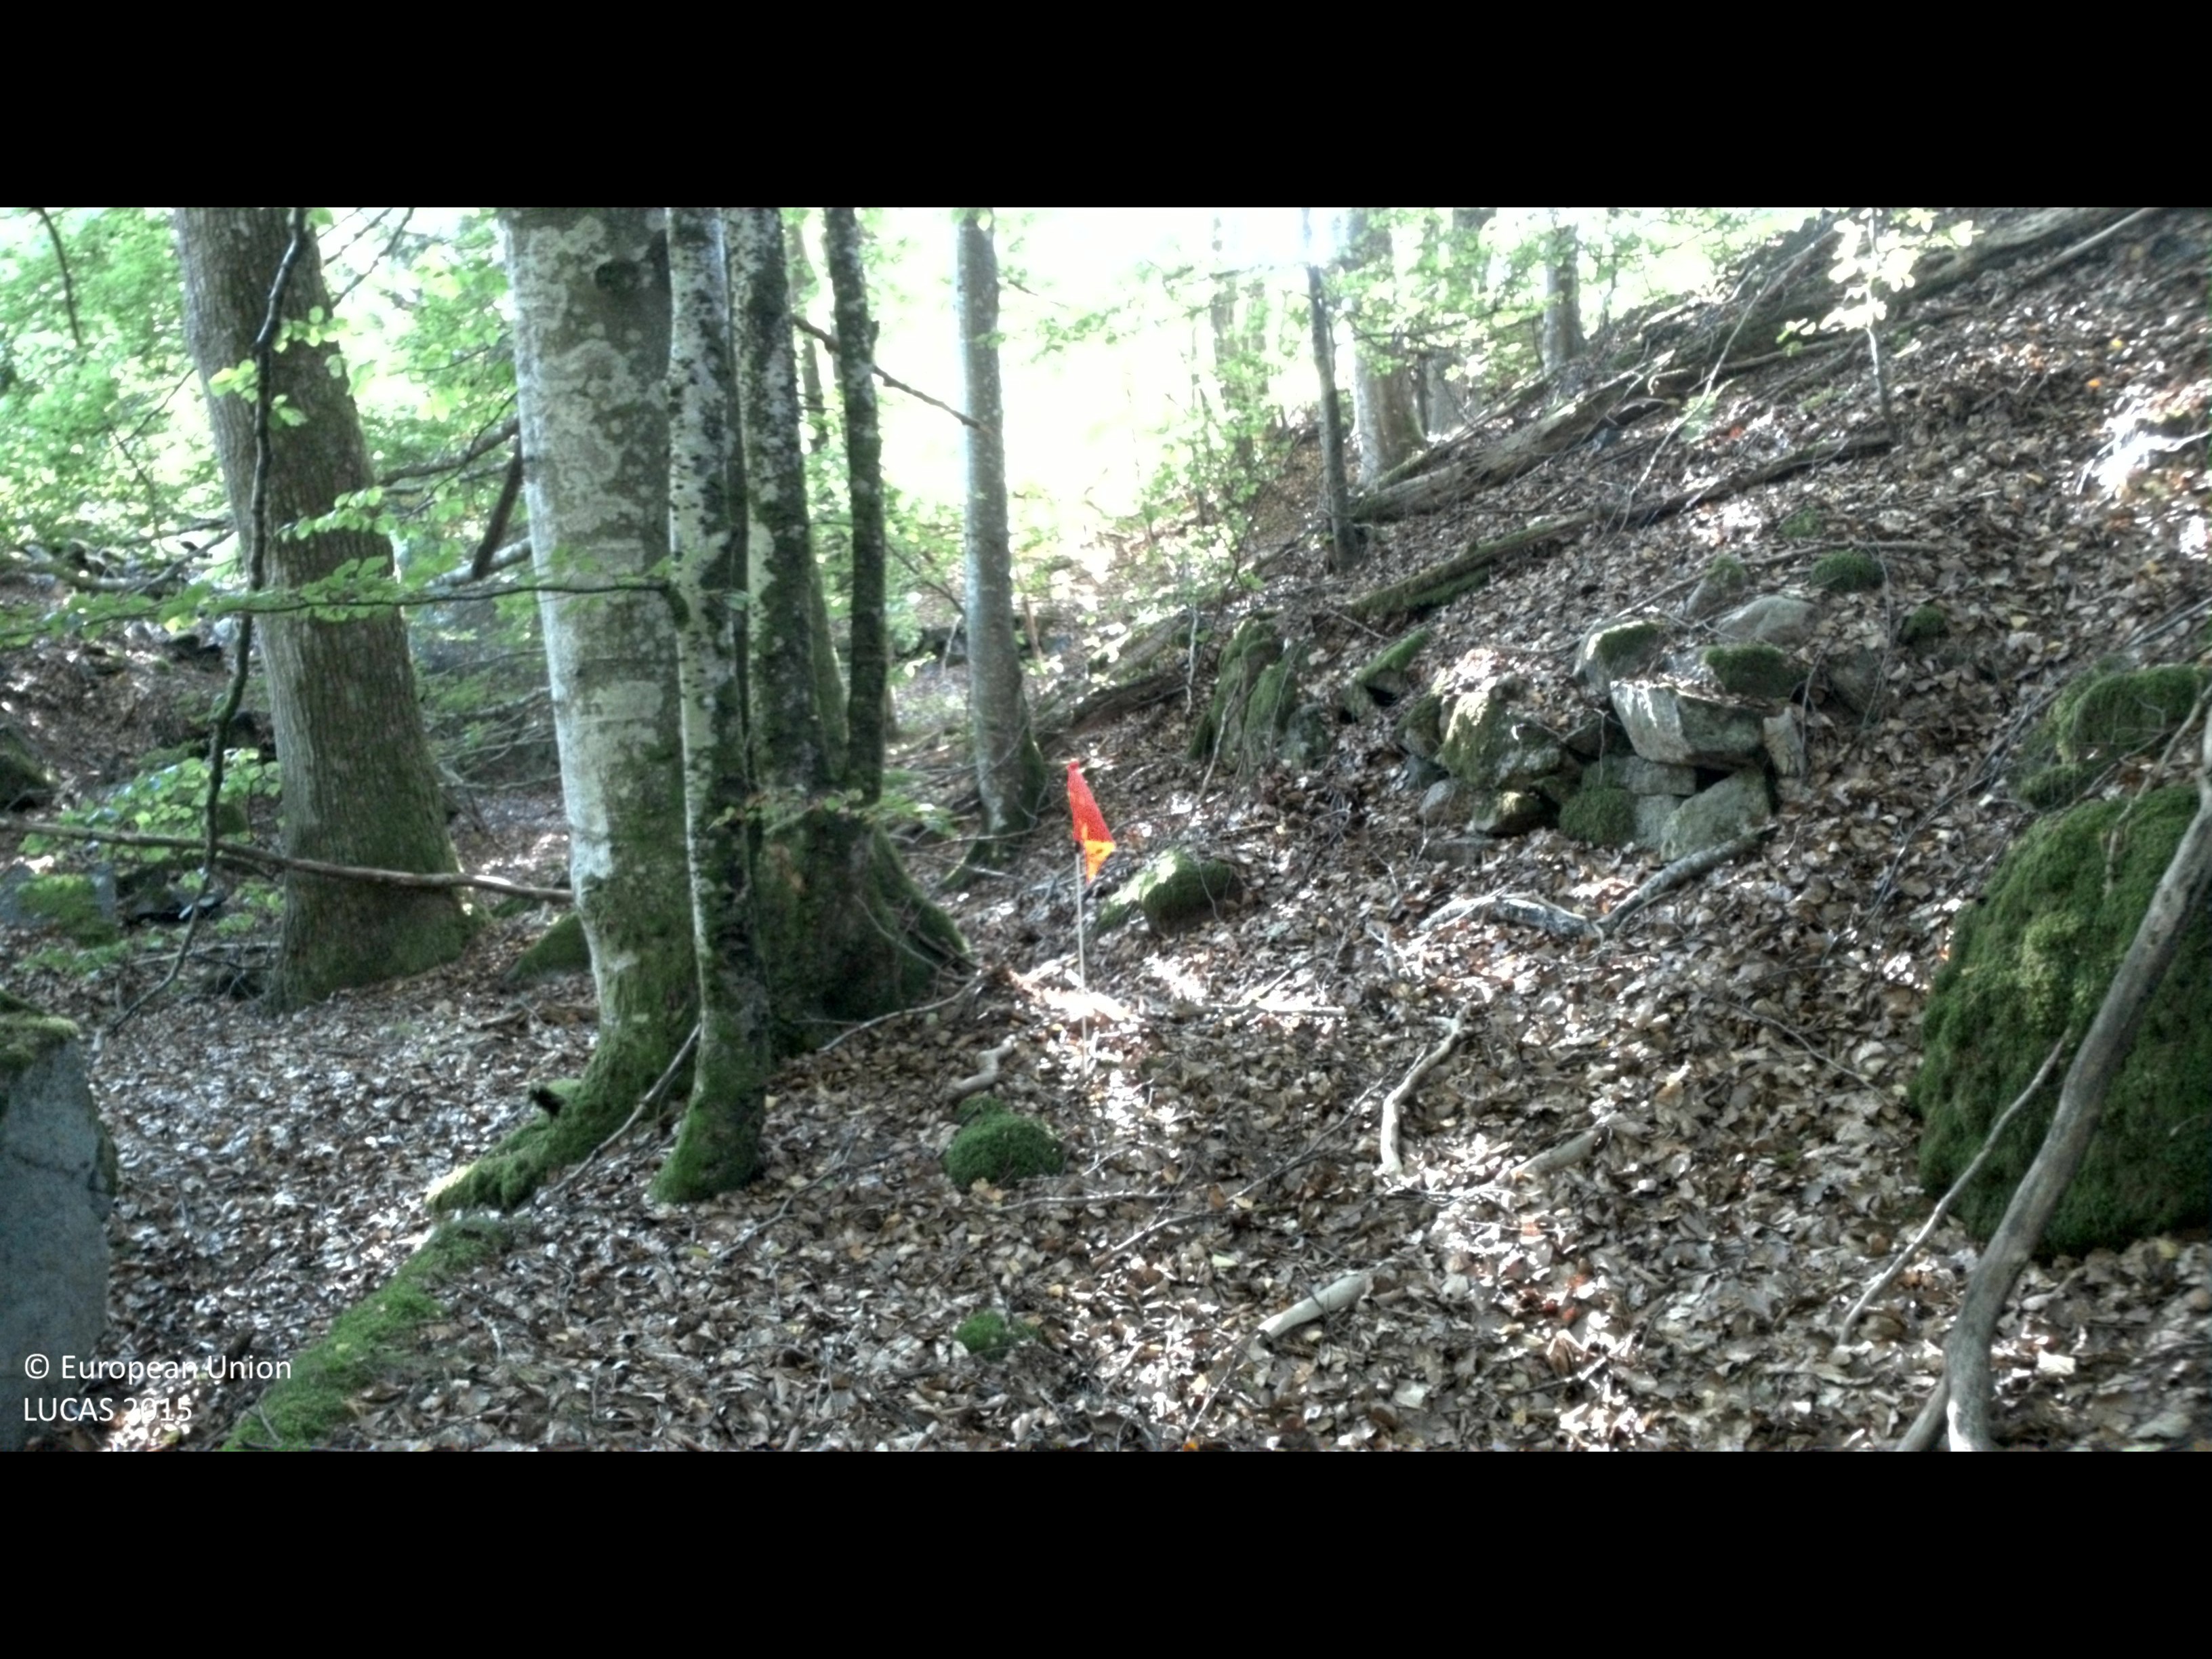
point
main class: Woodland
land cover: Broadleaved woodland
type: beech forest
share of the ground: > 75 %
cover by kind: broadleaved forest trees 80 %
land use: Forestry
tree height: > 5 m
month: September
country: SE
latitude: 56.1720
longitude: 14.2338
